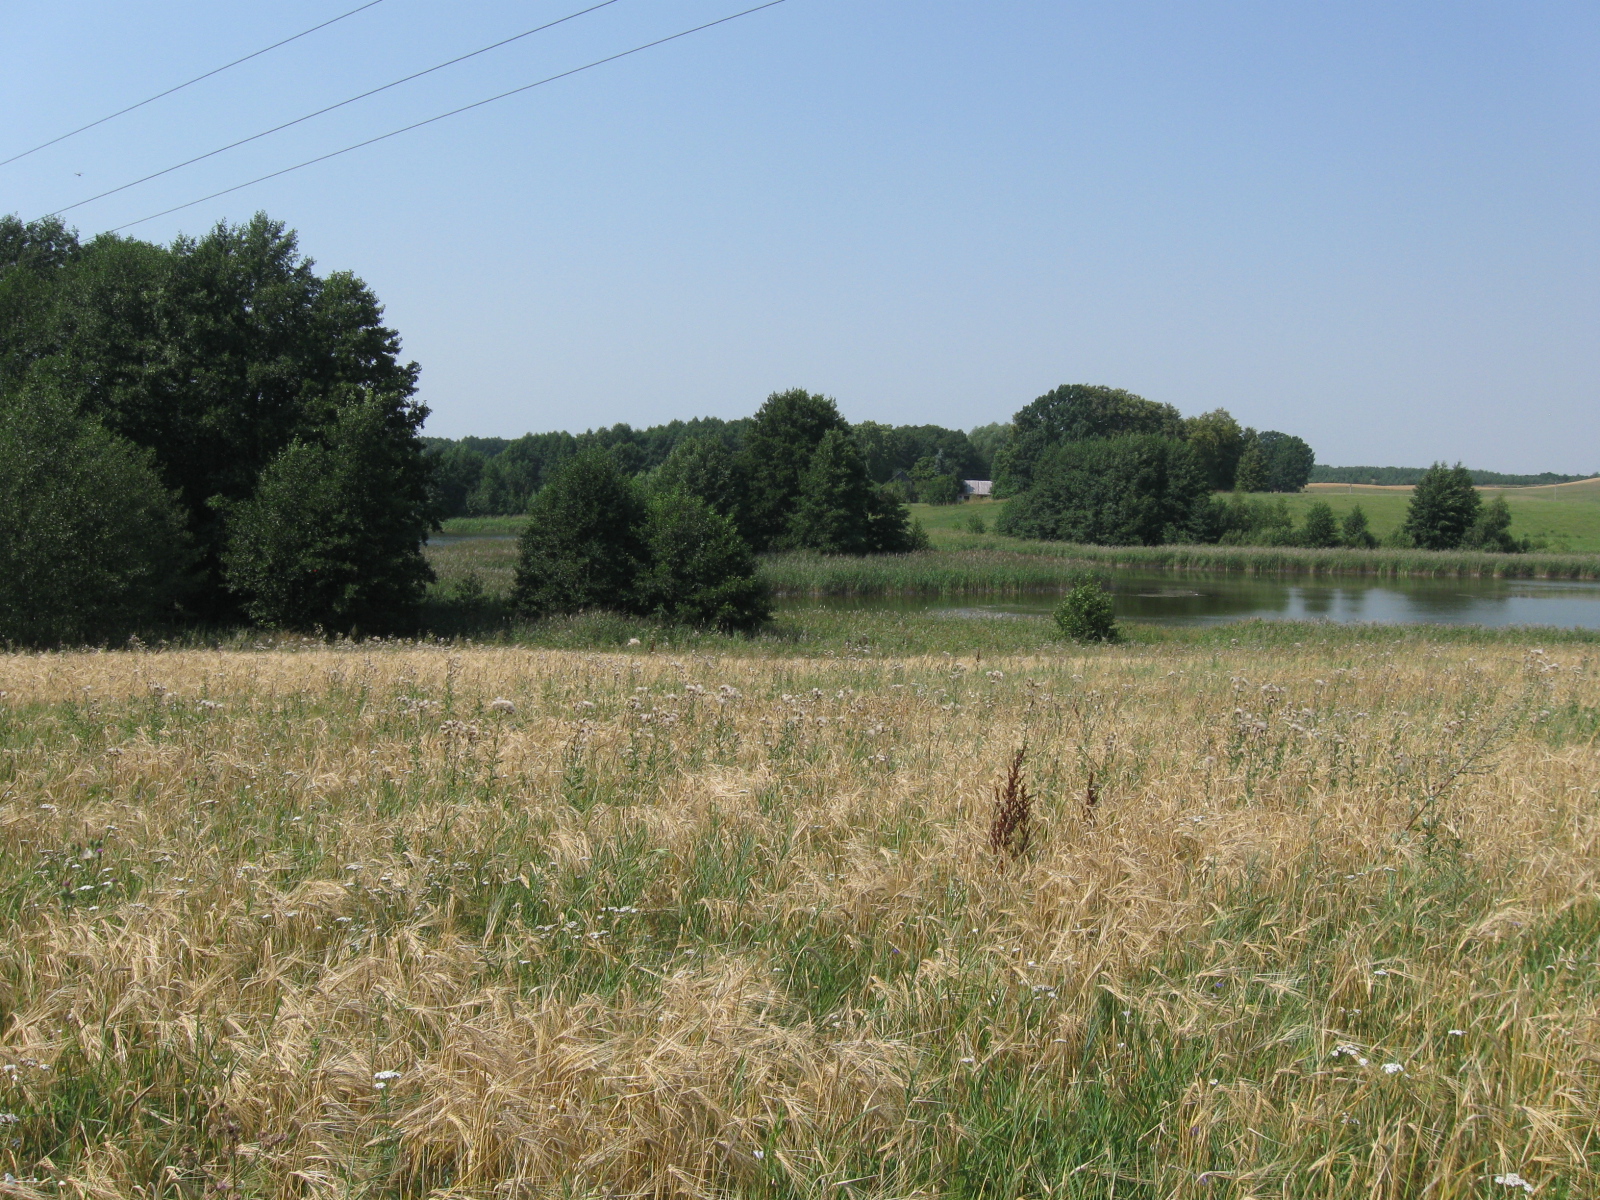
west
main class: Cropland
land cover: Barley
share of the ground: 50 - 75 %
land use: Agriculture (excluding fallow land and kitchen gardens)
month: August
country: LT
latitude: 54.3846
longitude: 23.2425
